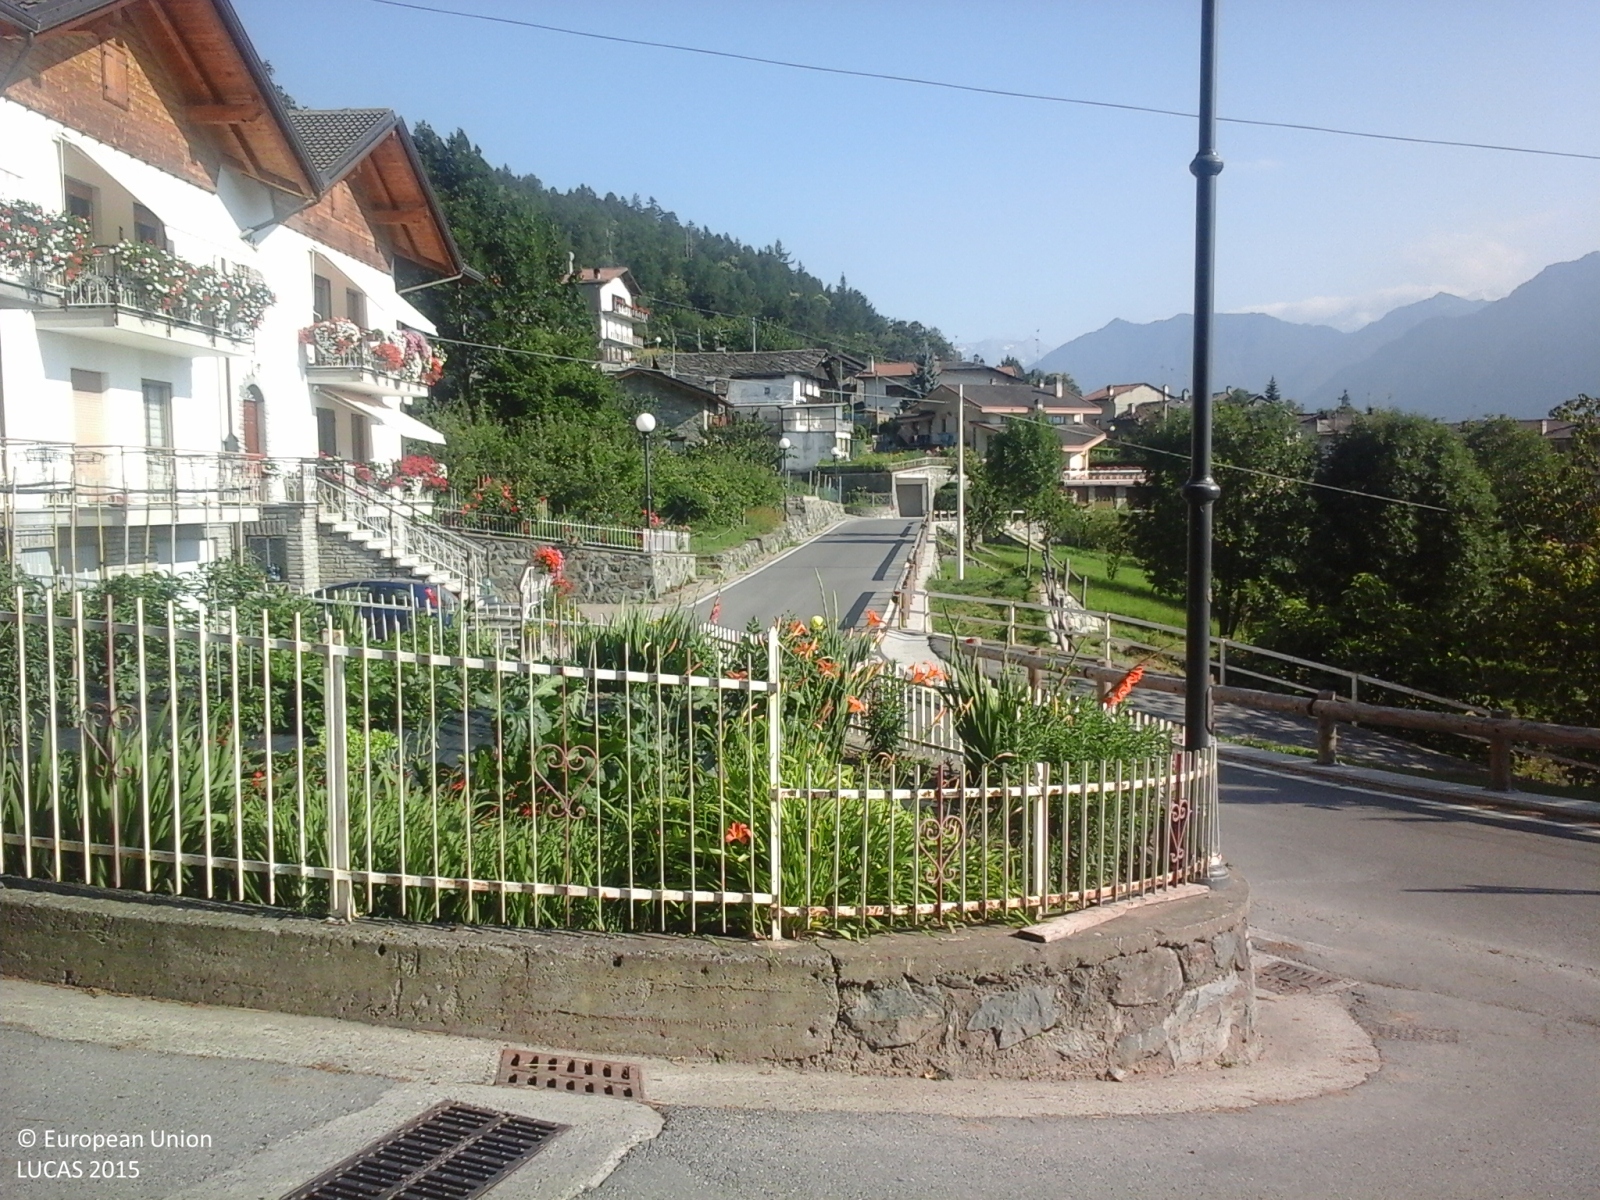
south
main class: Woodland
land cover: Broadleaved woodland
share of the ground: > 75 %
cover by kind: broadleaved forest trees 100 %
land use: Forestry
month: June
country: IT
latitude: 45.7313
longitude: 7.6774
